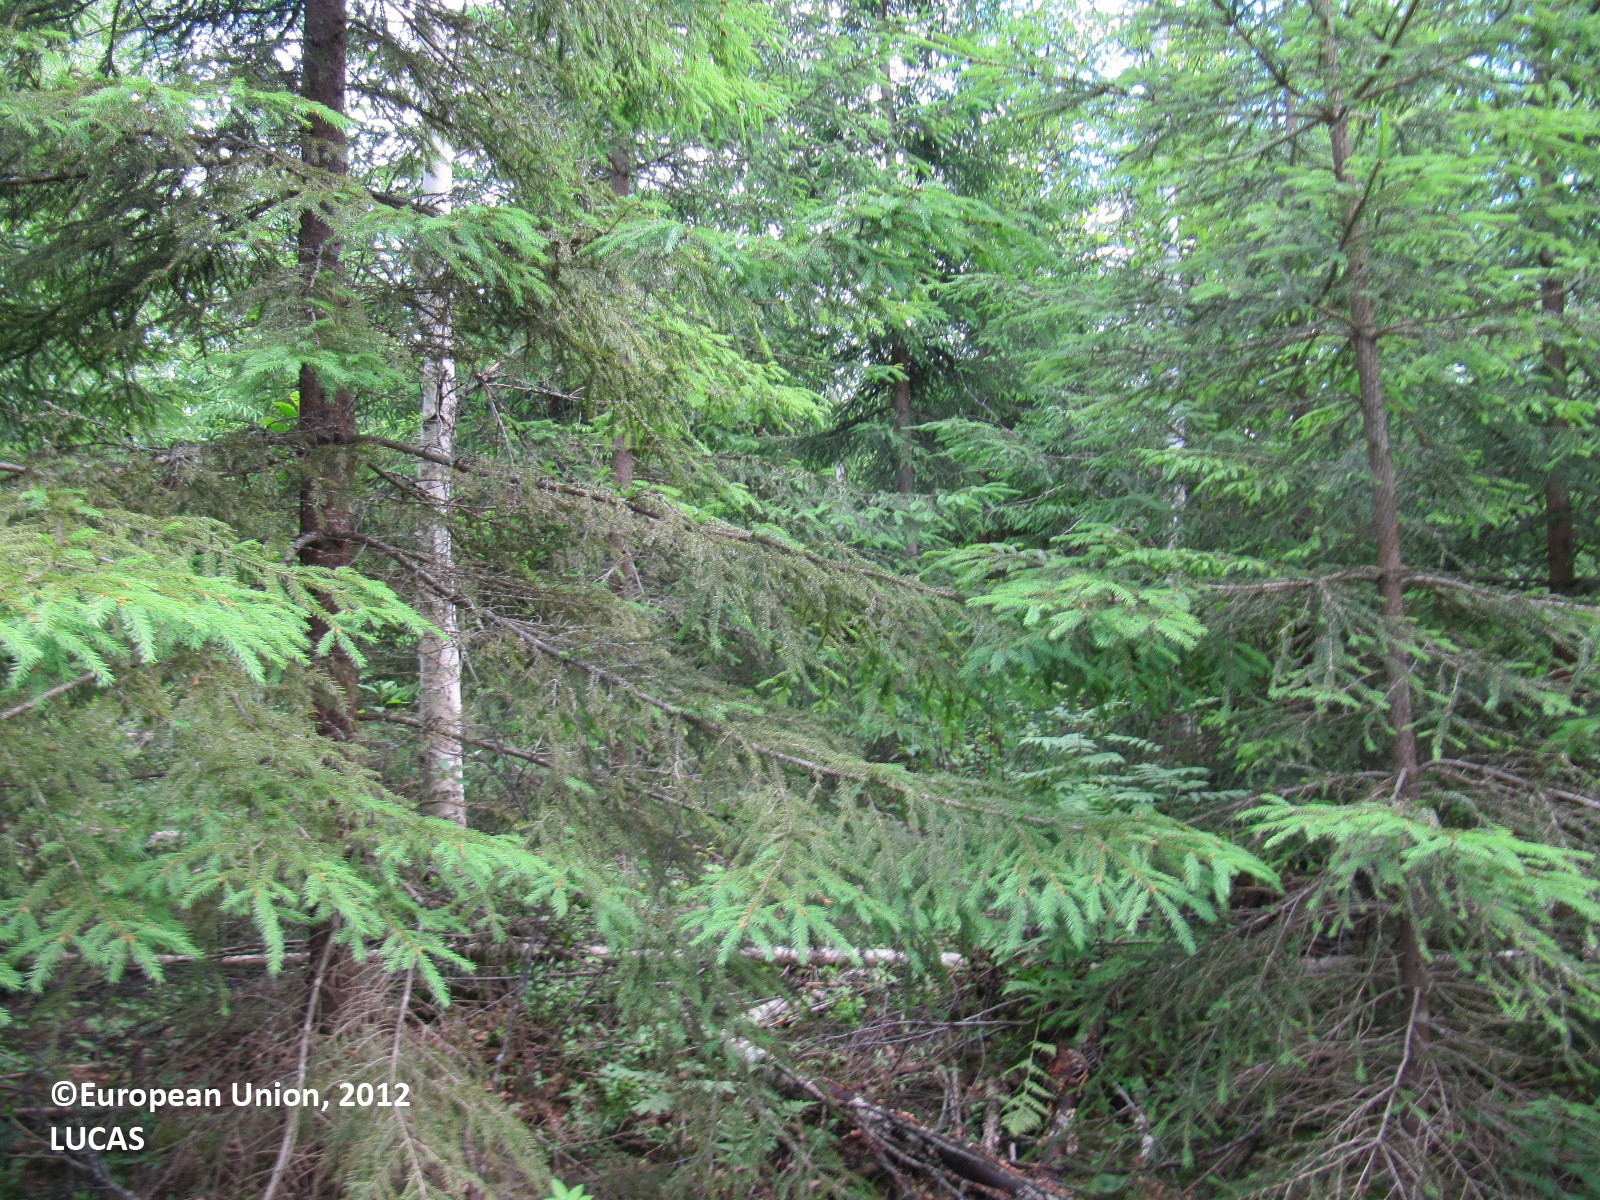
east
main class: Woodland
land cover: Spruce dominated mixed woodland
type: boreal forest
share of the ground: > 75 %
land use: Forestry
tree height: > 5 m
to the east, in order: Spruce dominated mixed woodland; Pine dominated coniferous woodland; Paved roads, cycling and walking lanes; Electric lines; Other mixed woodland; Pine dominated coniferous woodland
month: June
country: FI
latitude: 60.7690
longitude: 24.1031
